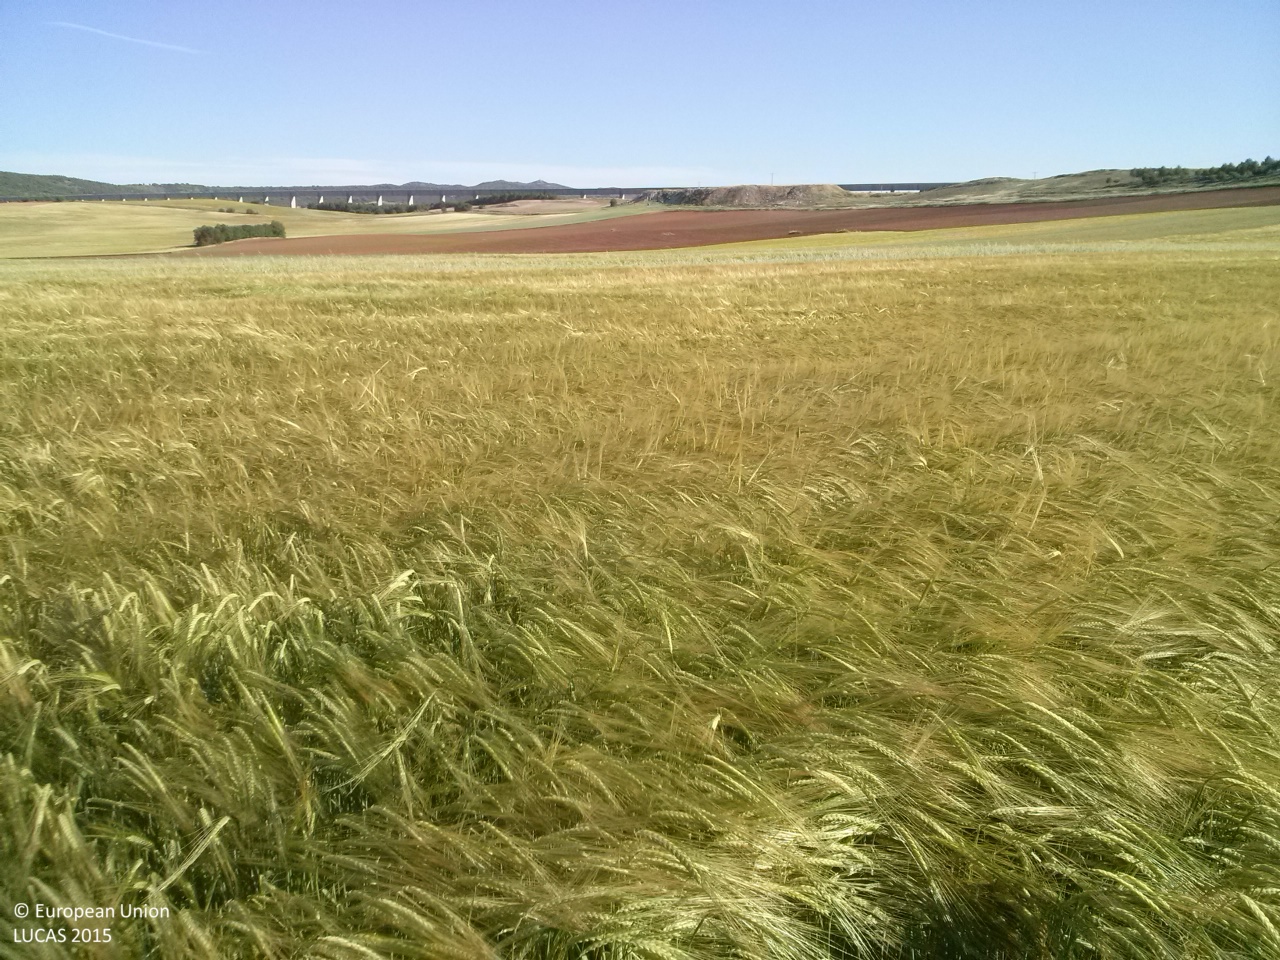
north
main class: Cropland
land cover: Barley
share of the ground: > 75 %
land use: Agriculture (excluding fallow land and kitchen gardens)
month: May
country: ES
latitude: 40.0637
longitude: -2.8134
